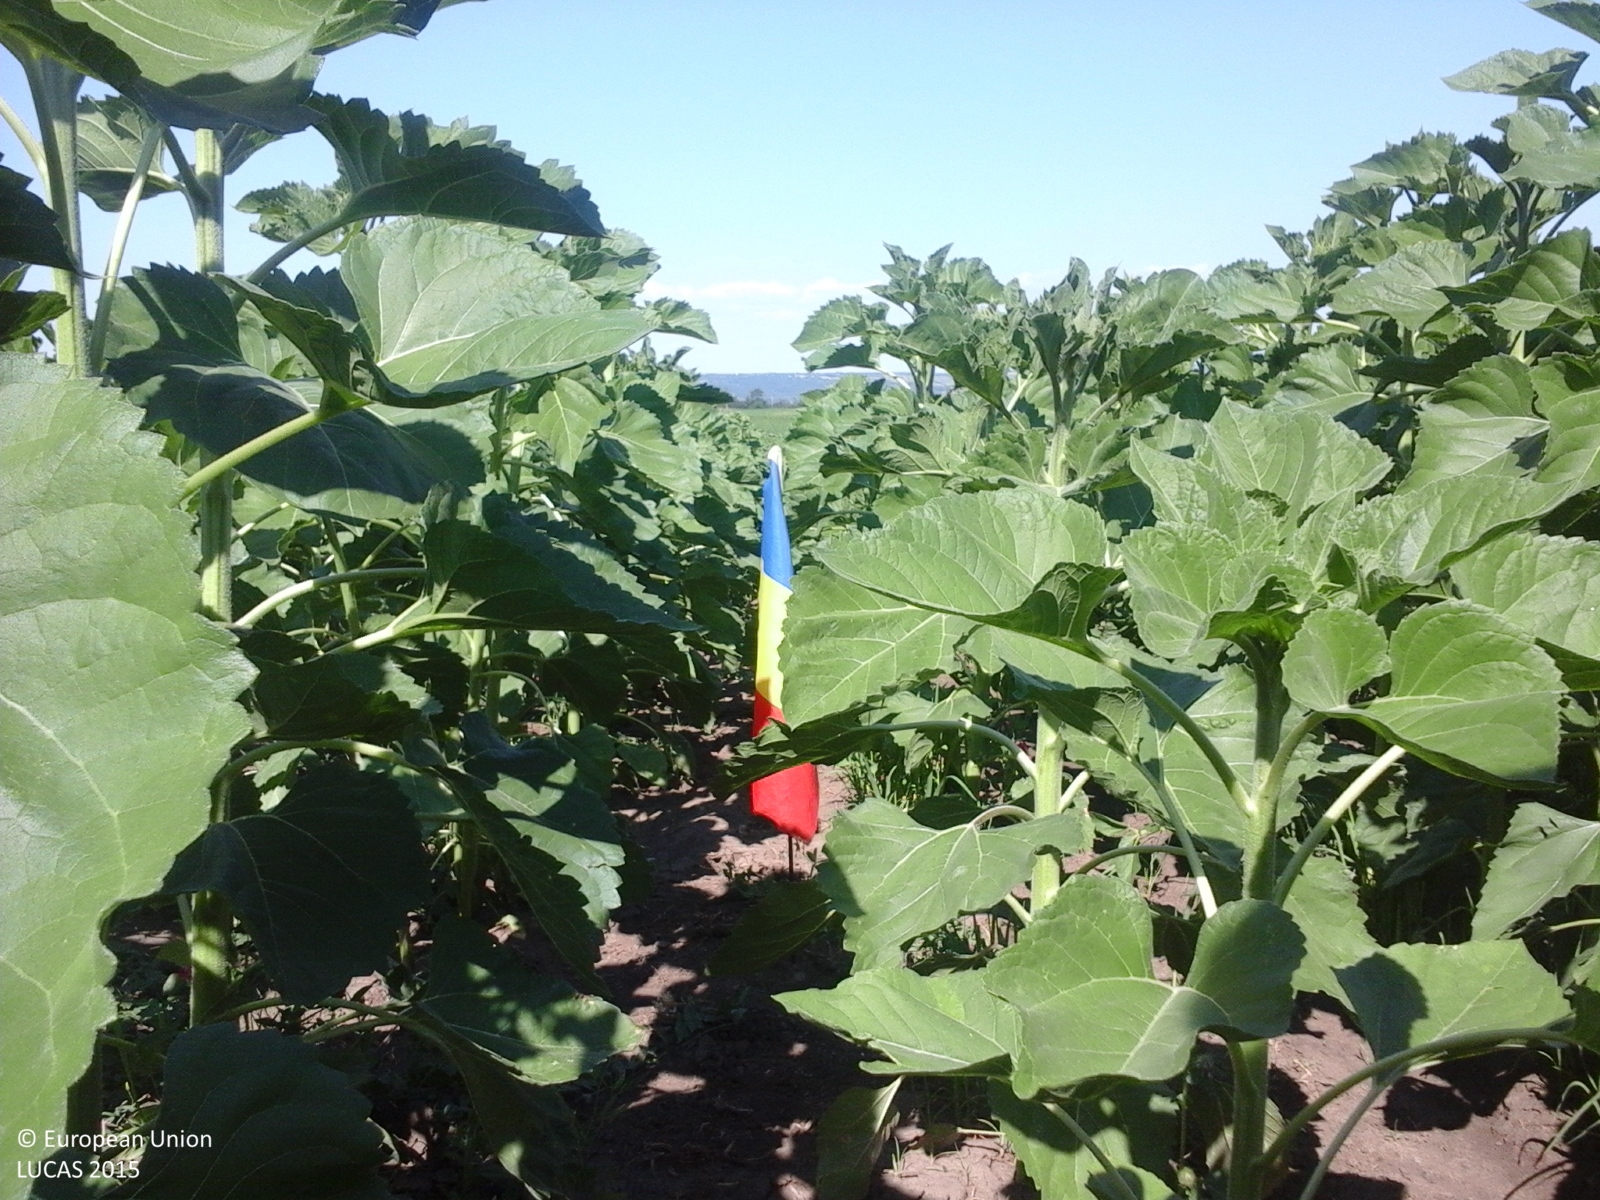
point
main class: Cropland
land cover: Sunflower
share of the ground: > 75 %
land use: Agriculture (excluding fallow land and kitchen gardens)
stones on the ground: < 10 %
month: June
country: RO
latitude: 47.4000
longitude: 27.4881
